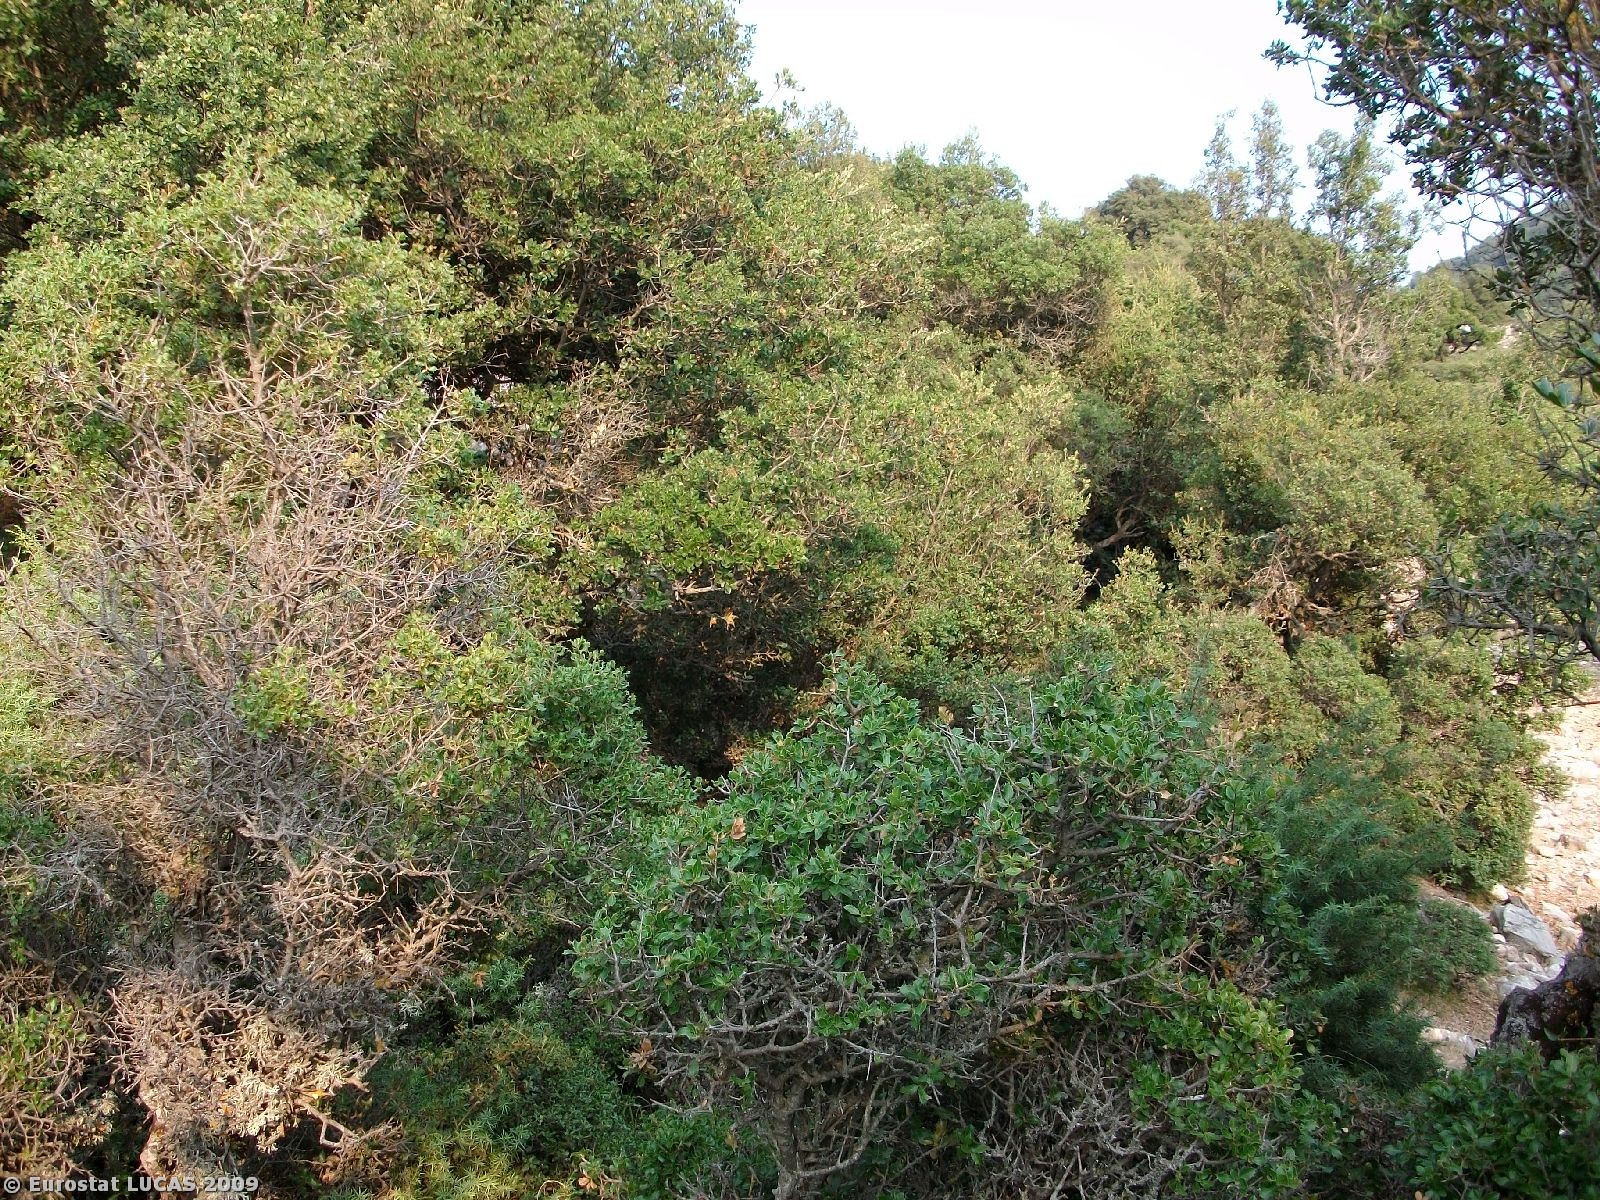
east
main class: Woodland
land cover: Broadleaved woodland
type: thermophilous deciduous forest
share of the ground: > 75 %
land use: Forestry
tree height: > 5 m
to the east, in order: Broadleaved woodland; Paved roads, cycling and walking lanes; Shrubland without tree cover; Paved roads, cycling and walking lanes; Shrubland with sparse tree cover; Tracks; Fences; Shrubland with sparse tree cover; Fences; Shrubland without tree cover
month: August
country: GR
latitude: 38.9562
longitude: 21.5954
